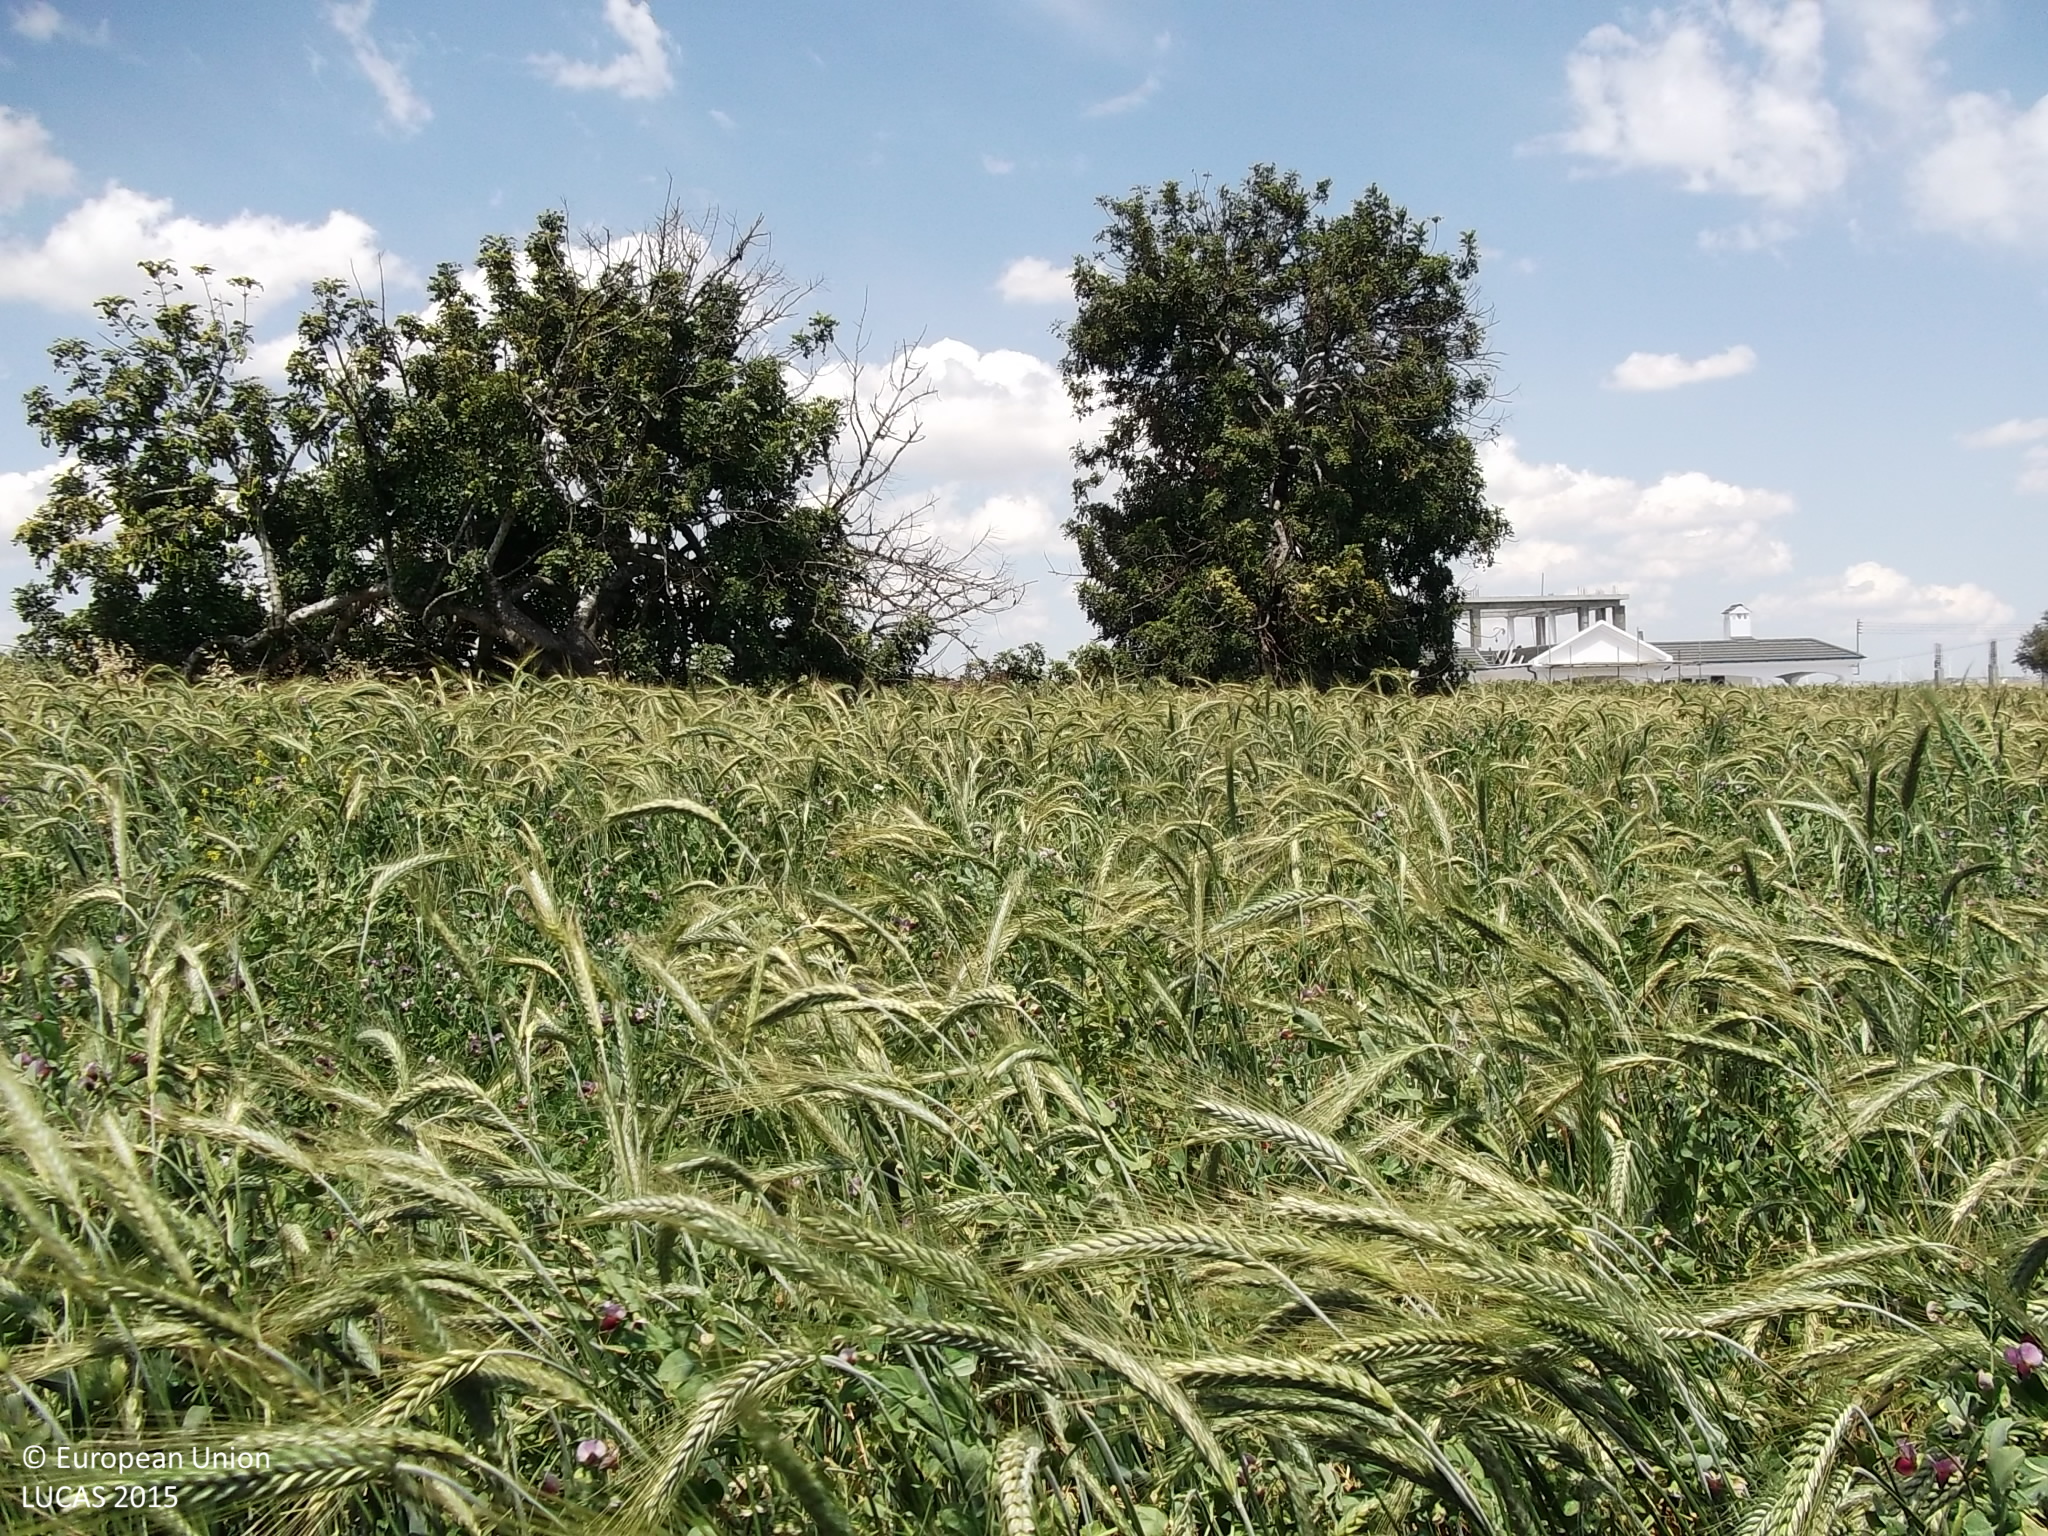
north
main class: Cropland
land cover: Permanent industrial crops
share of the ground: 25 - 50 %
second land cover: Common wheat
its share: > 75 %
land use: Agriculture (excluding fallow land and kitchen gardens)
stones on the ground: 25 - 50 %
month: April
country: CY
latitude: 34.8015
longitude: 33.4790
